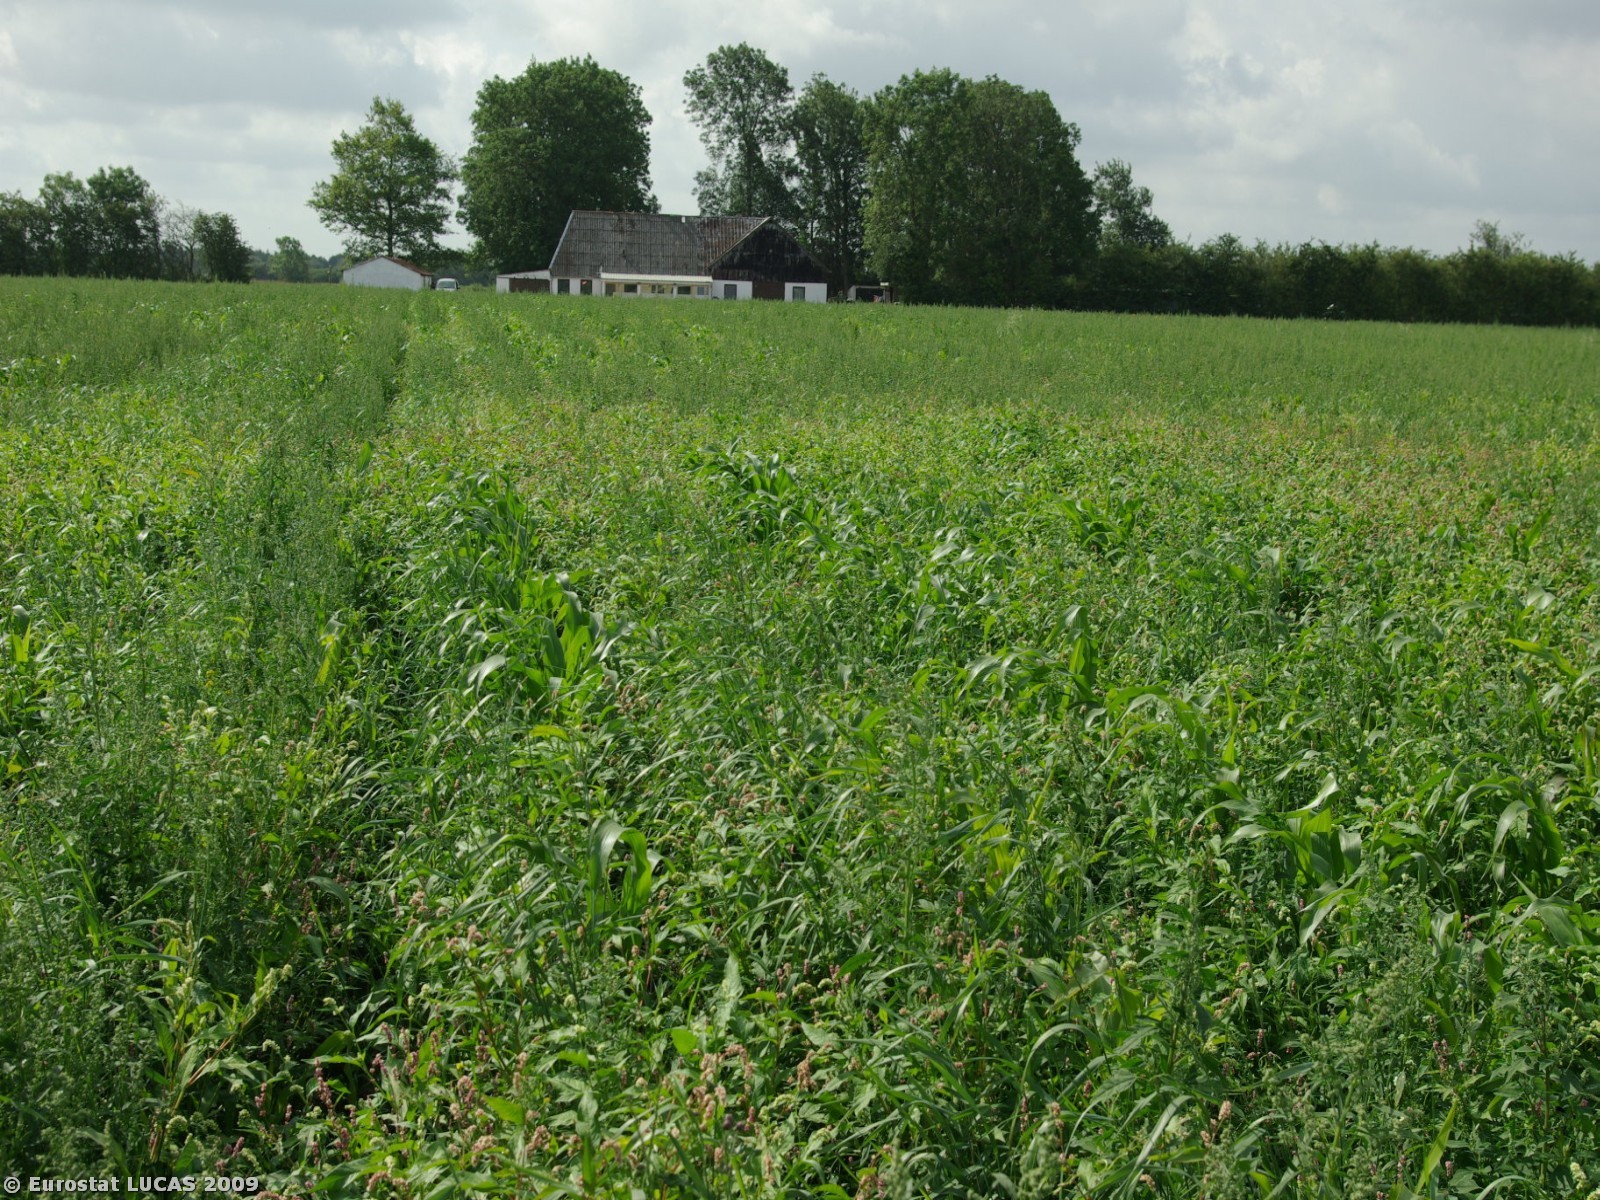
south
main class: Cropland
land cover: Maize
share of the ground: 10 - 25 %
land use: Agriculture (excluding fallow land and kitchen gardens)
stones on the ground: < 10 %
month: July
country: DK
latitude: 54.9096
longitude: 9.2986
